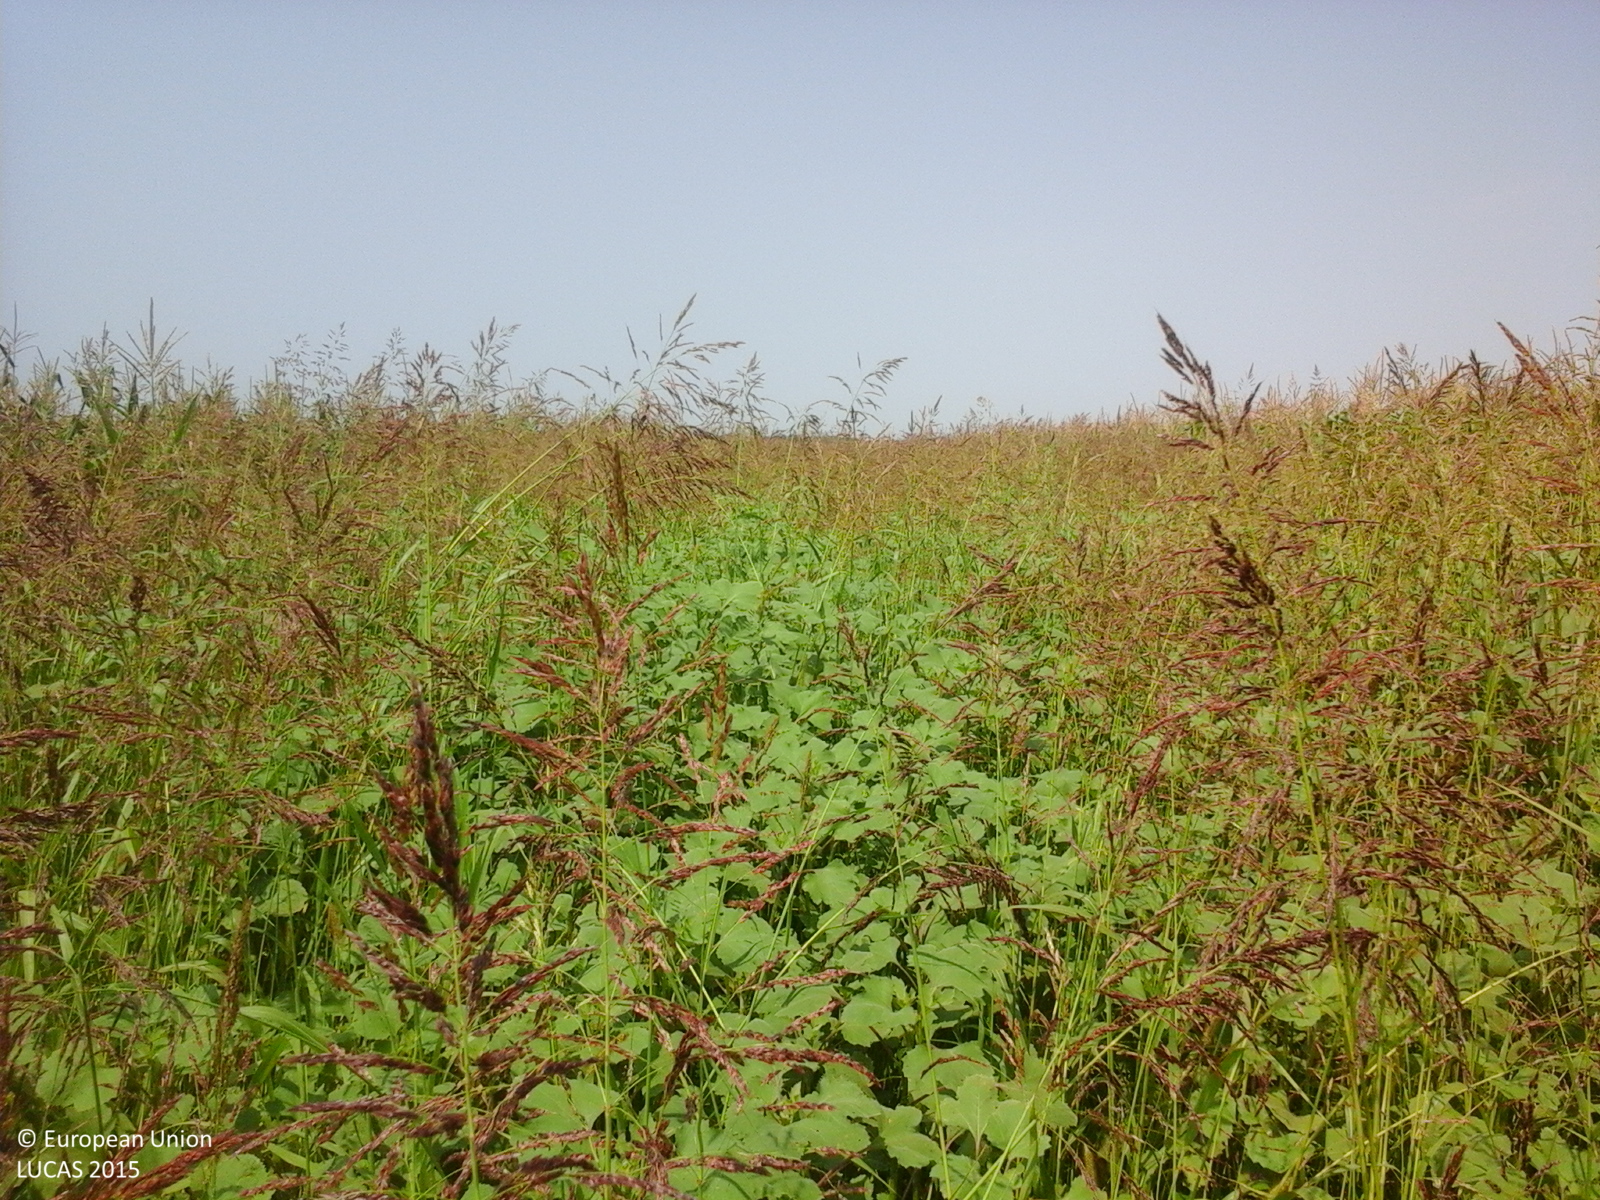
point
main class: Grassland
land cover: Spontaneously vegetated surfaces
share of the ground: > 75 %
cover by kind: herbaceous plants 100 %
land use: Fallow land
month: July
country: RO
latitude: 44.6076
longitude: 26.5616
